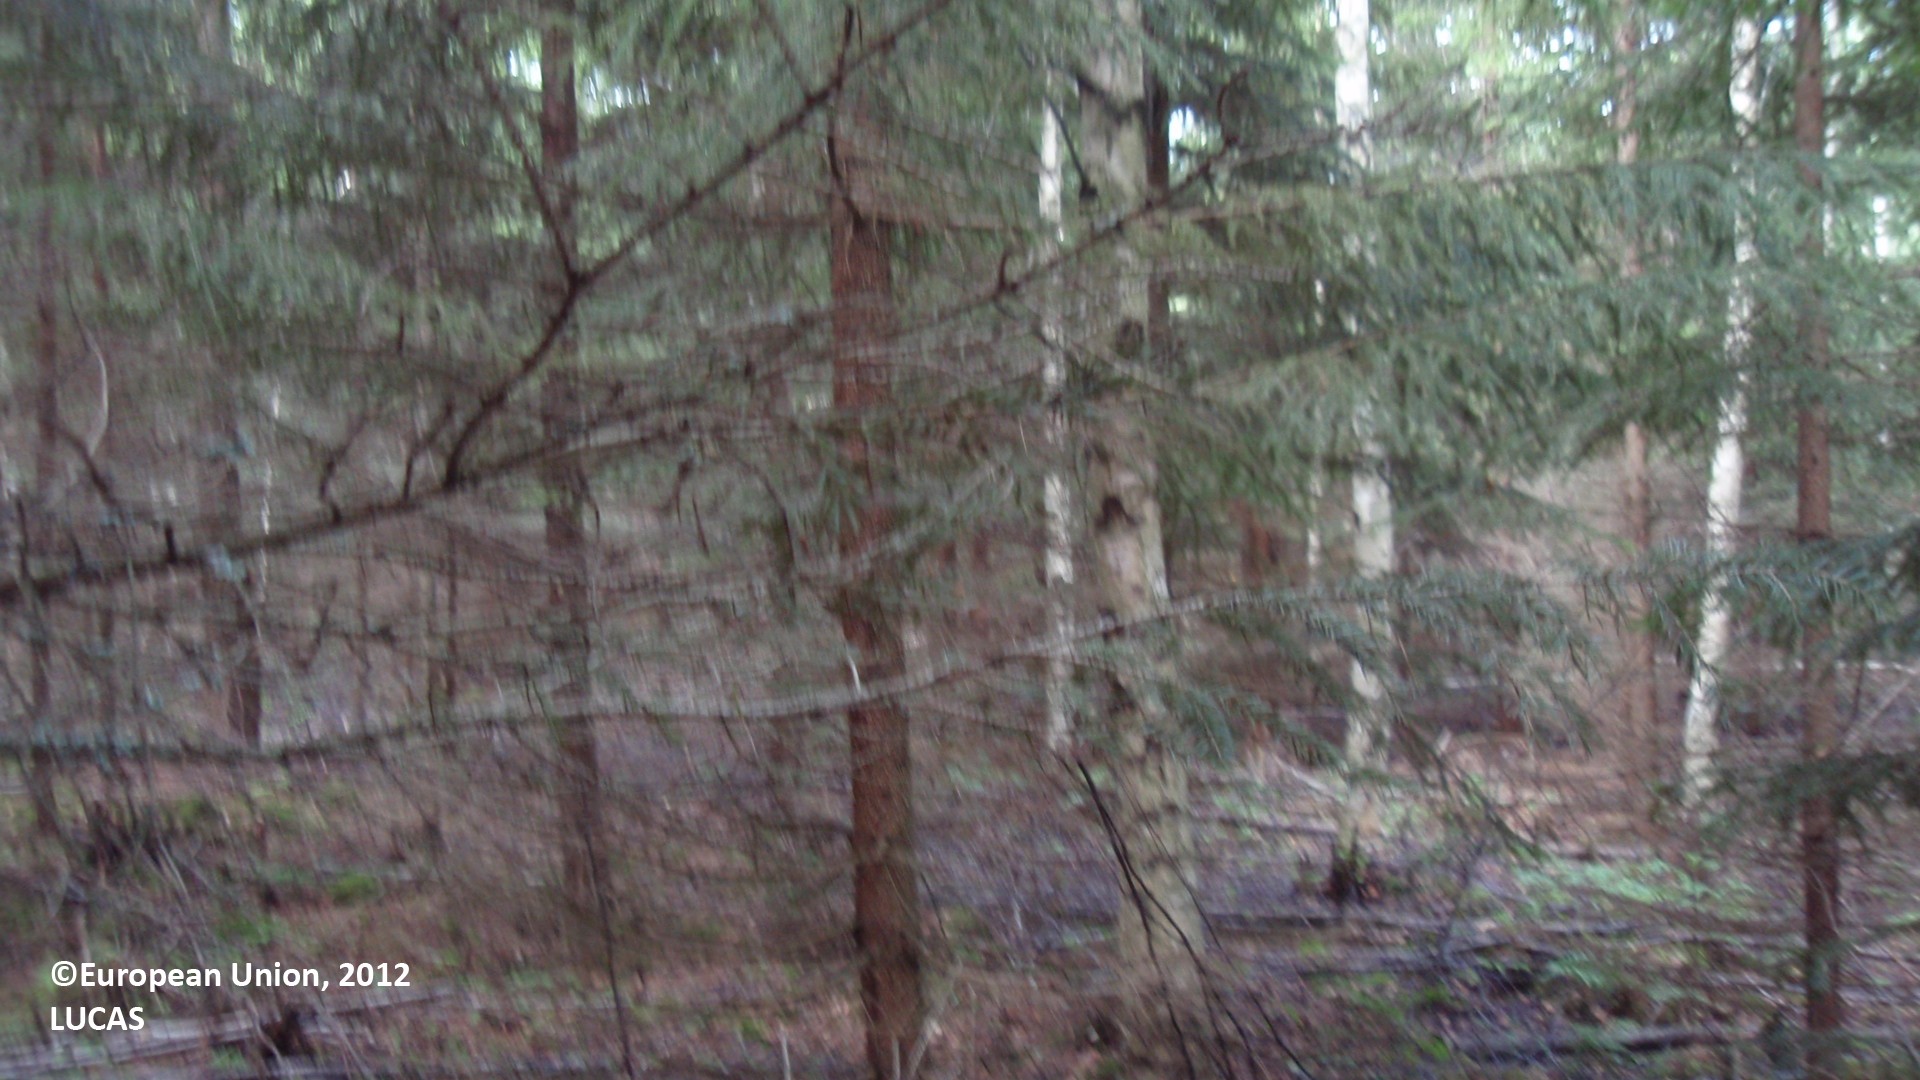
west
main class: Woodland
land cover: Spruce dominated mixed woodland
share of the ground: > 75 %
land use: Forestry
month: August
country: FI
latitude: 61.3060
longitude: 27.7183
